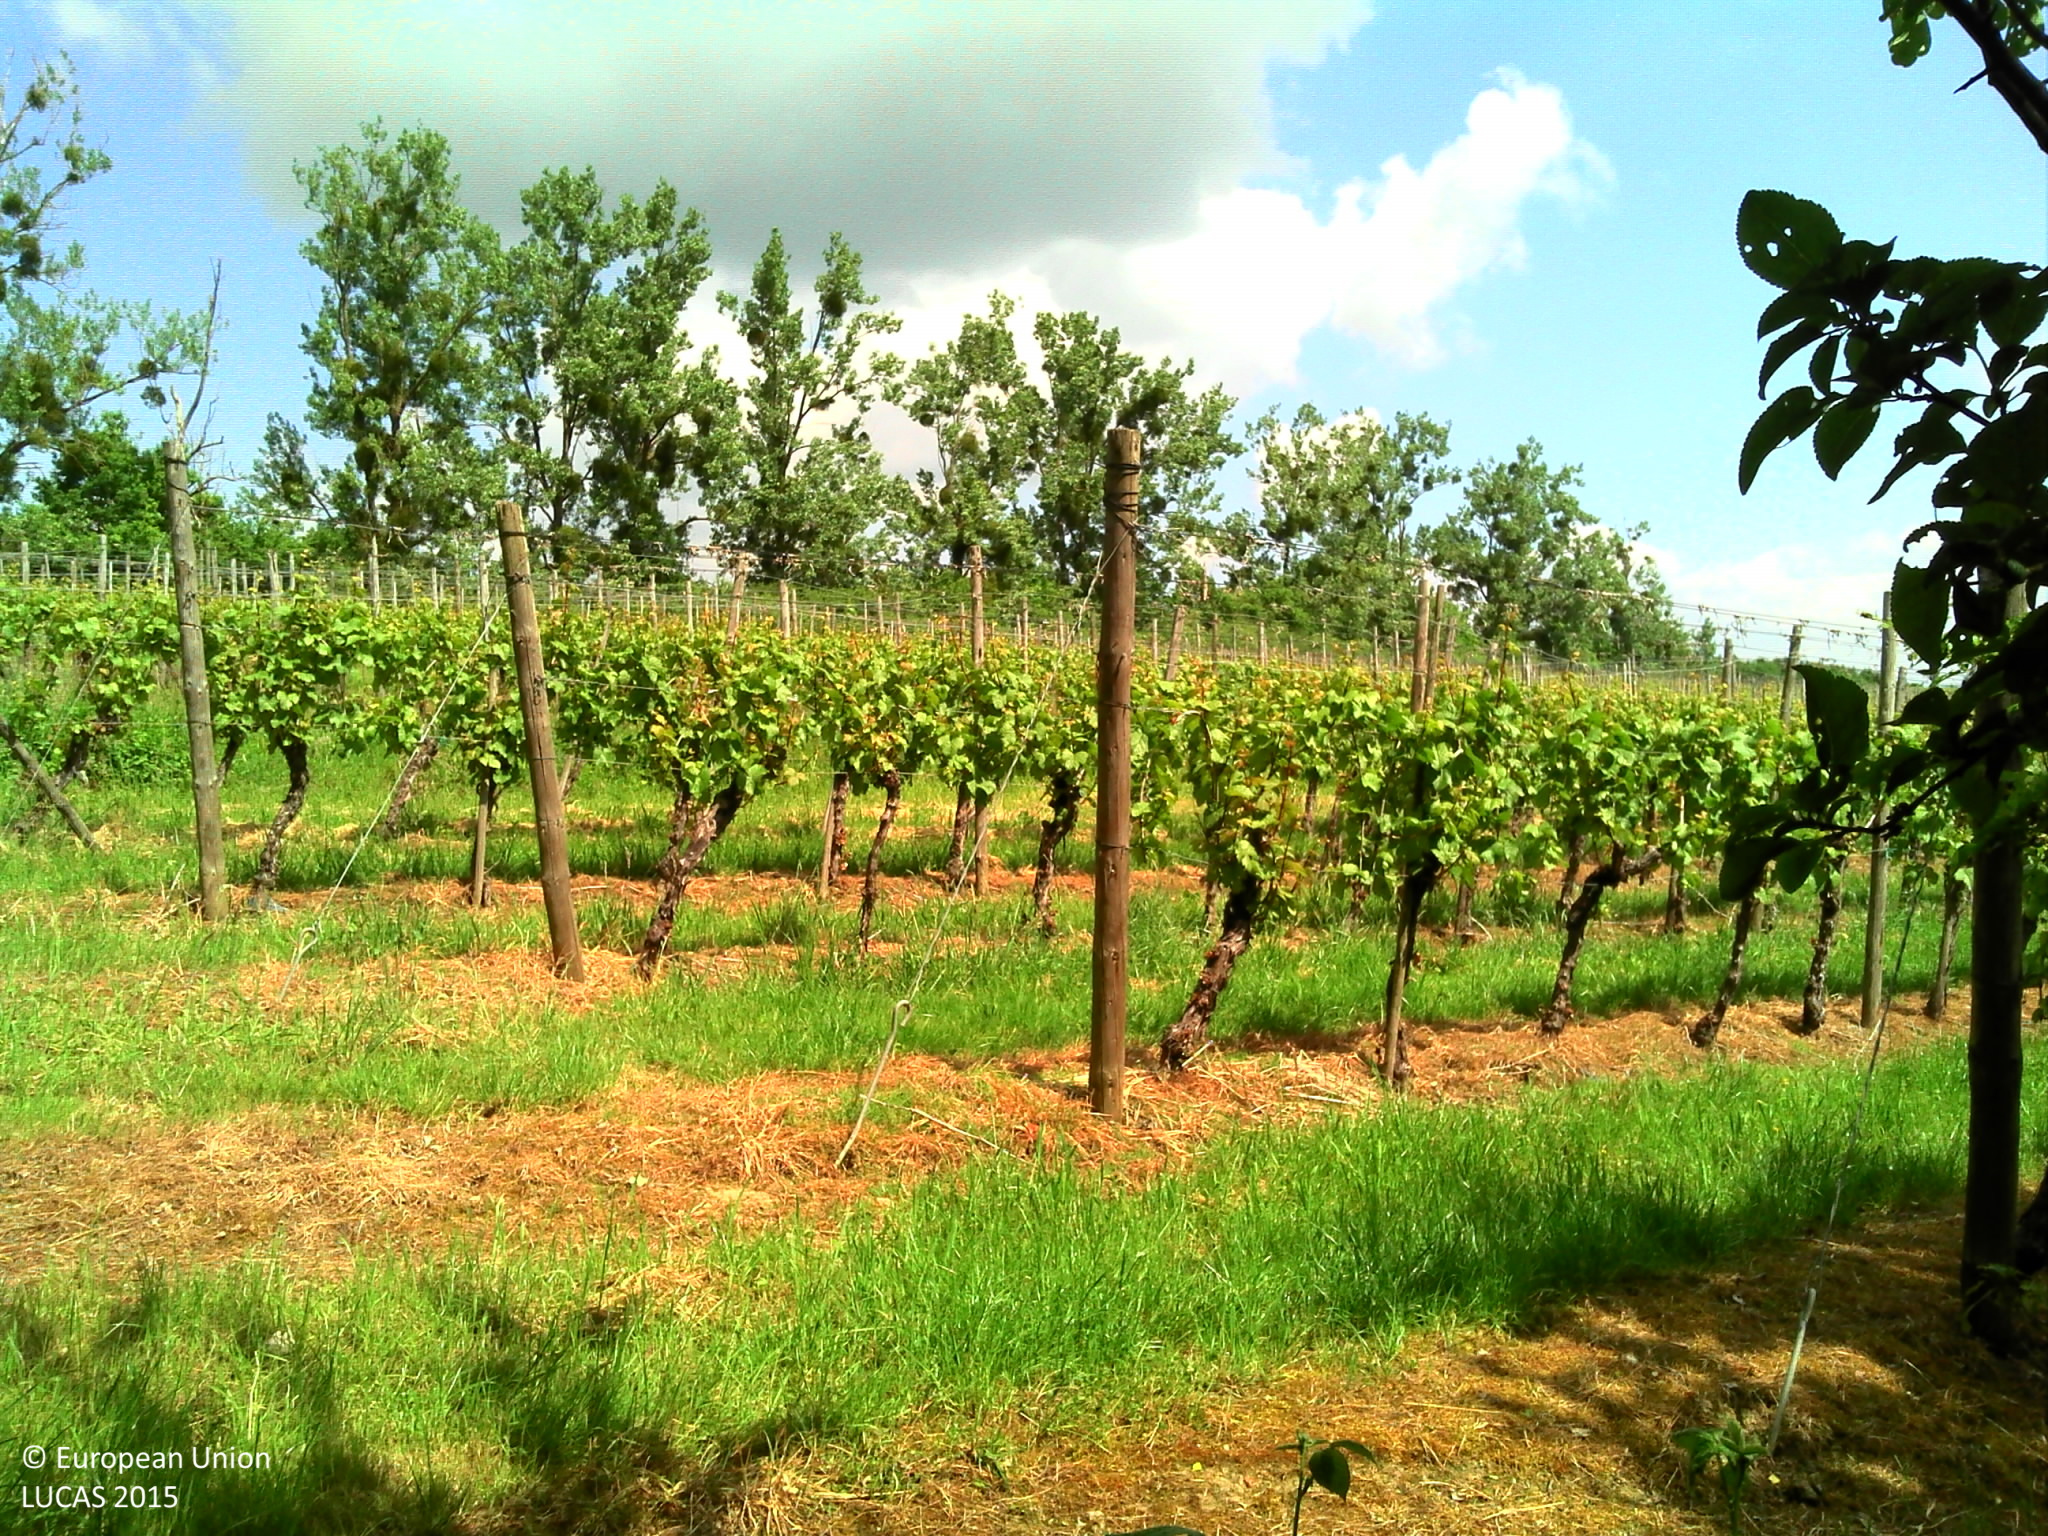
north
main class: Woodland
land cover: Broadleaved woodland
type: mesophytic deciduous forest
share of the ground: > 75 %
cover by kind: broadleaved forest trees 80 %, shrubs 20 %
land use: Semi-natural and natural areas not in use
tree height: > 5 m
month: May
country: LU
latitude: 49.7163
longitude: 6.4908
